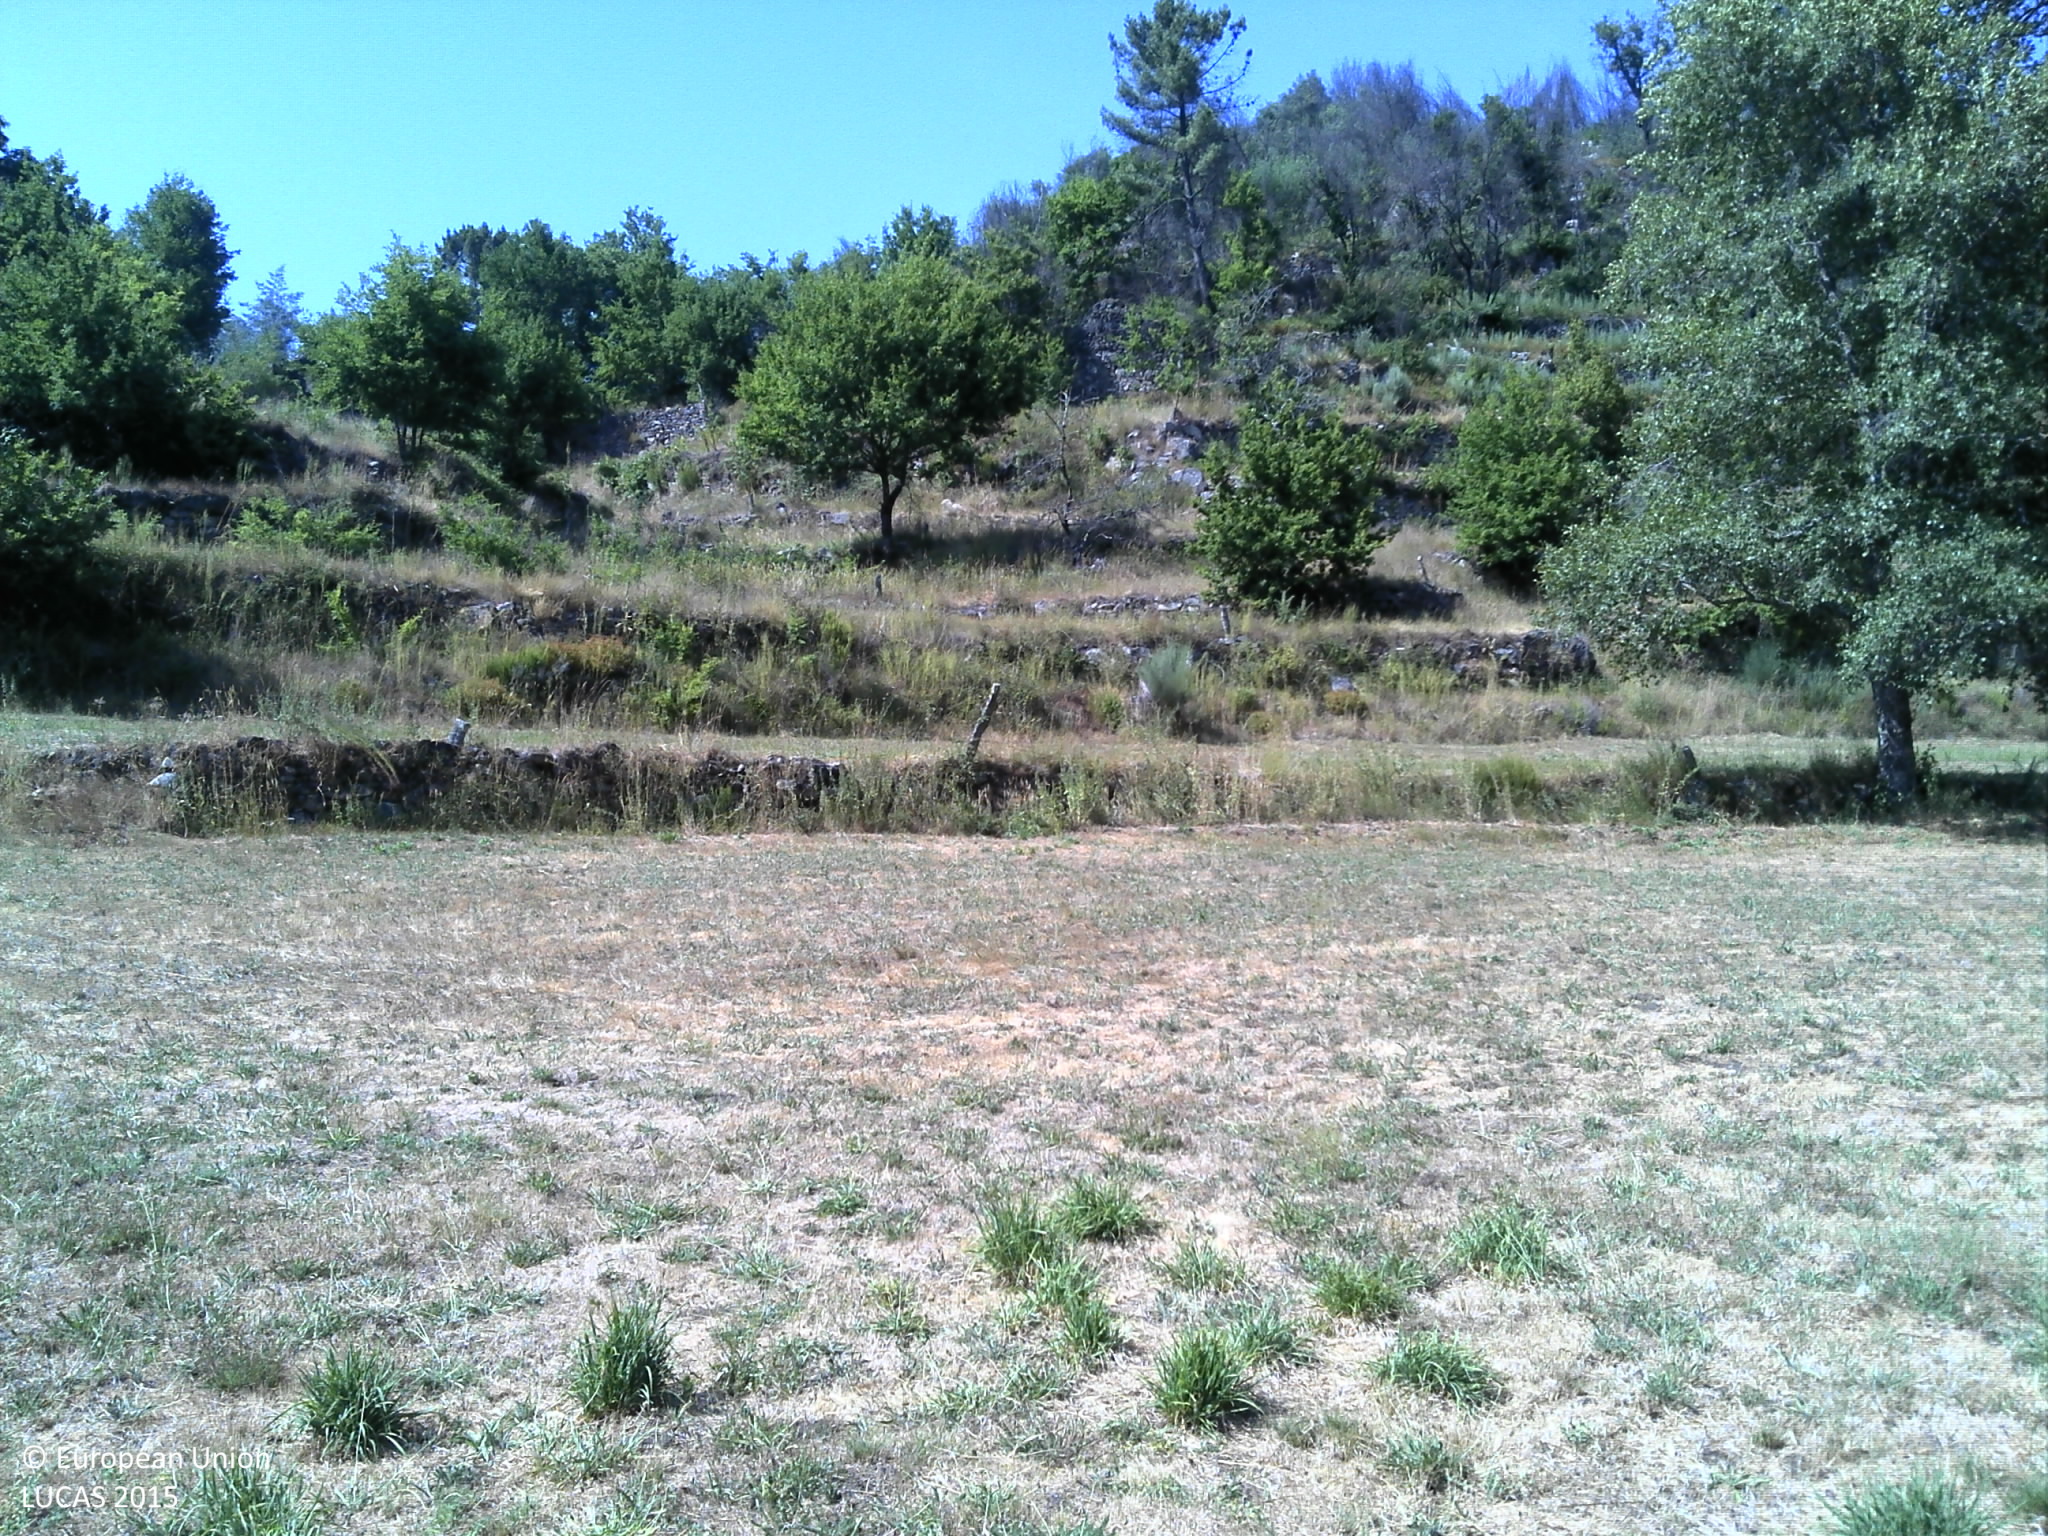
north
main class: Grassland
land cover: Grassland without tree/shrub cover
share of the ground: > 75 %
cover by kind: herbaceous plants 100 %
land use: Agriculture (excluding fallow land and kitchen gardens)
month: July
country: PT
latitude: 40.9053
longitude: -7.8511
